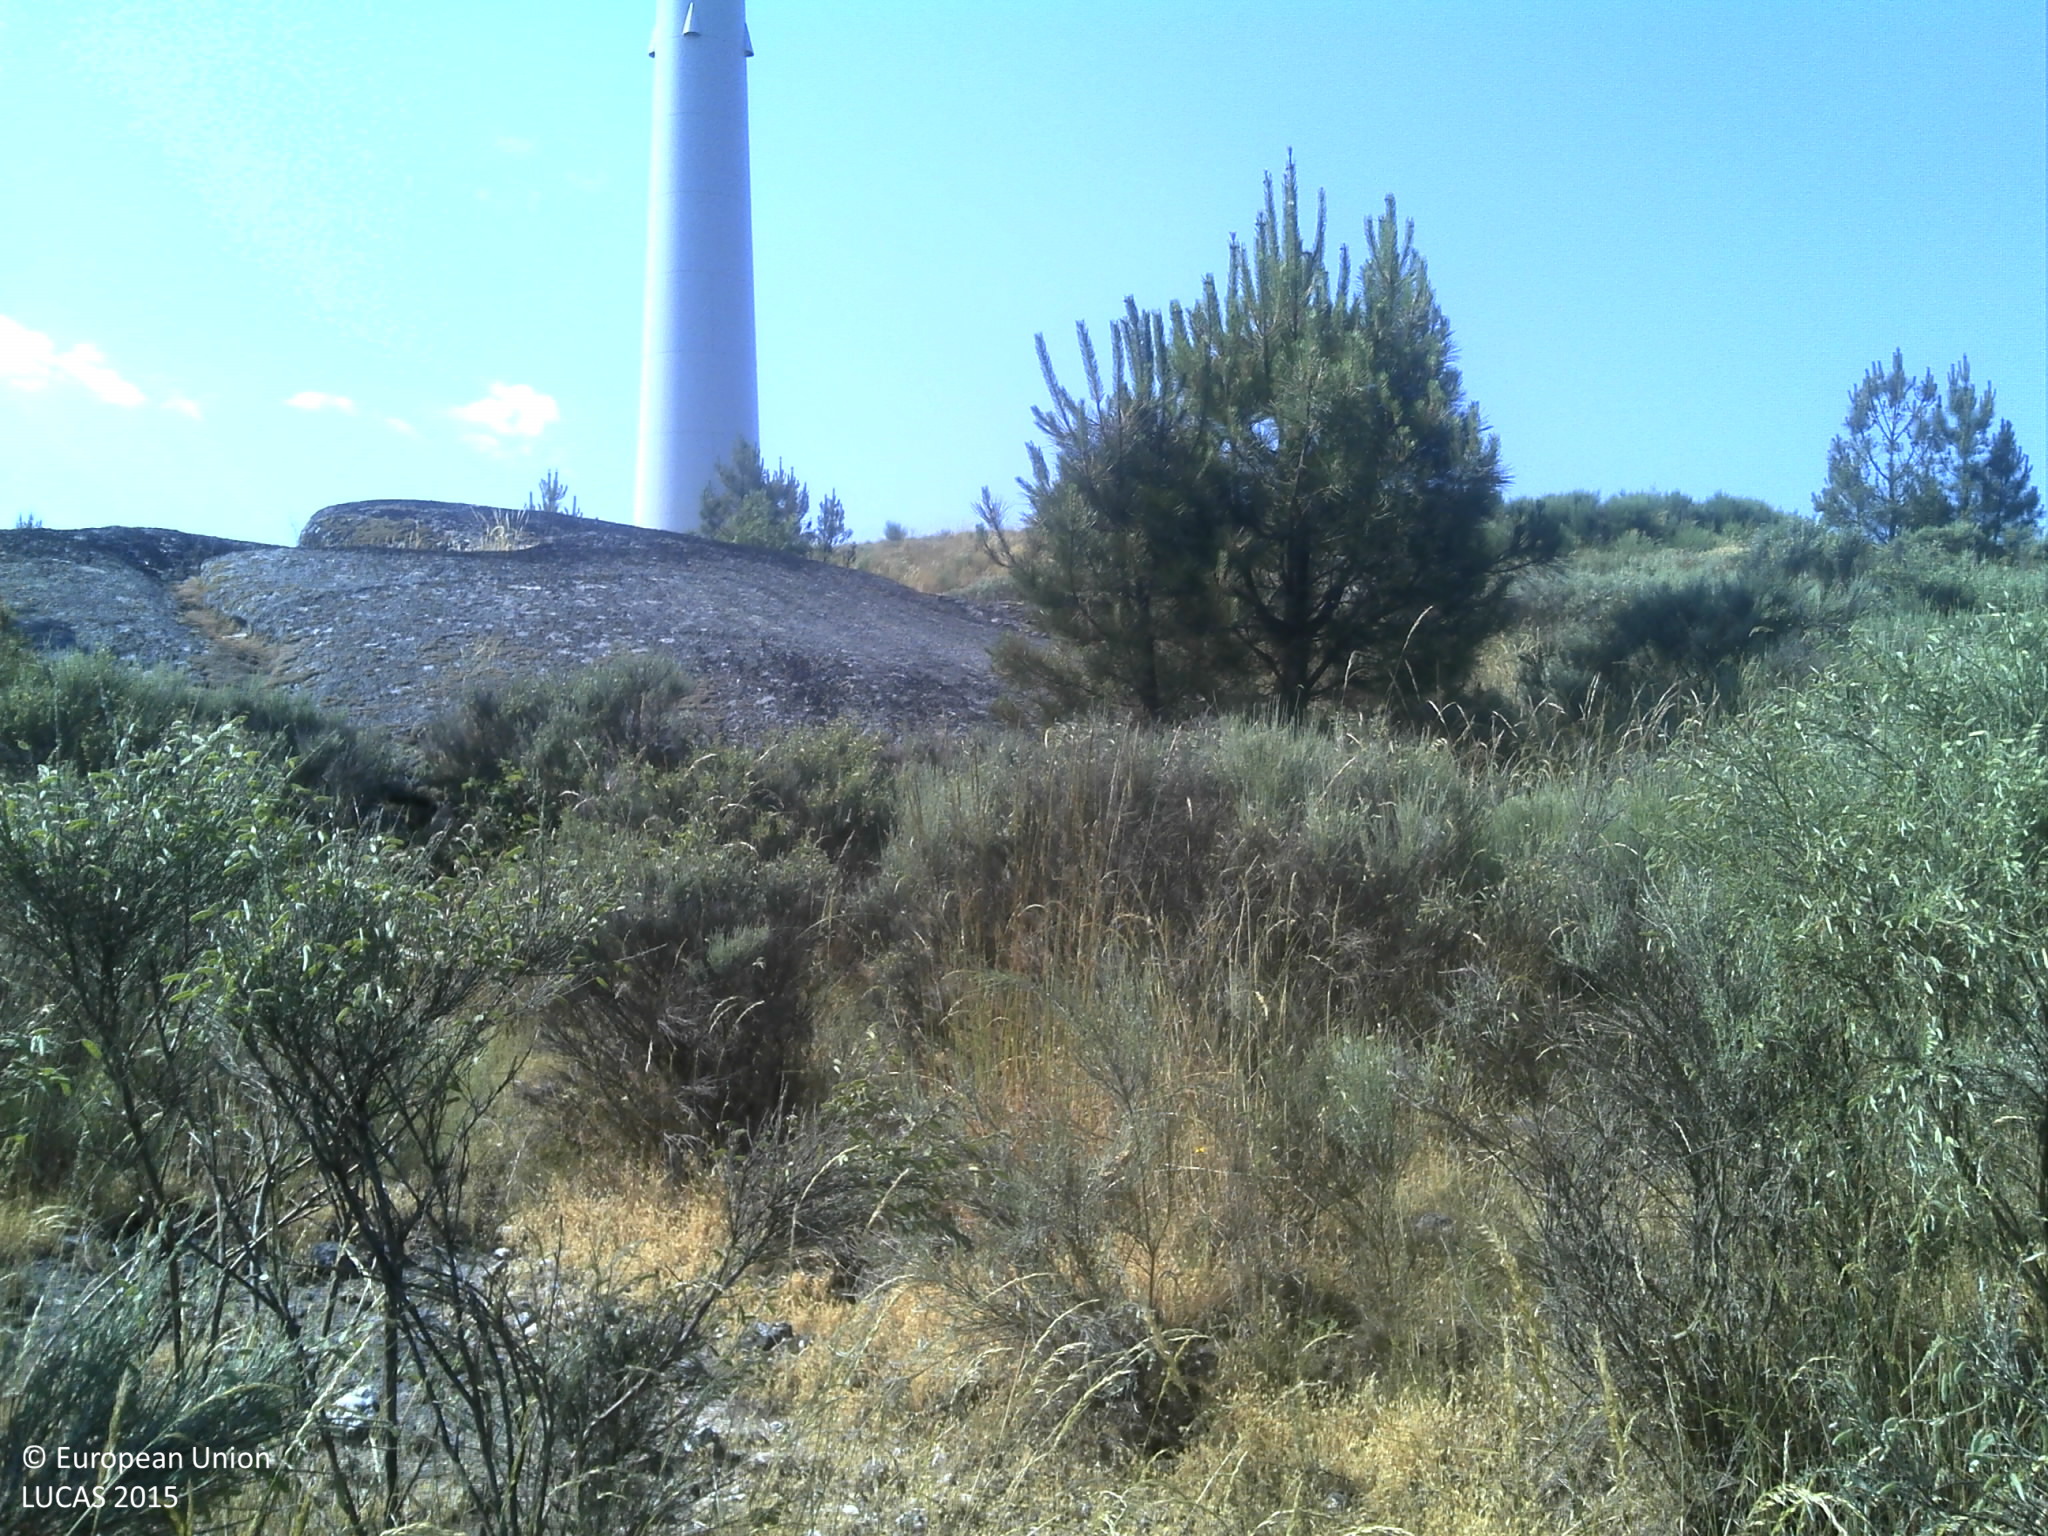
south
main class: Shrubland
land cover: Shrubland with sparse tree cover
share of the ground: 50 - 75 %
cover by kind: shrubs 75 %, unconsolidated bare surface 15 %, broadleaved forest trees 5 %, herbaceous plants 5 %
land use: Semi-natural and natural areas not in use
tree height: < 5 m
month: June
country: PT
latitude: 40.4001
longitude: -7.1739
